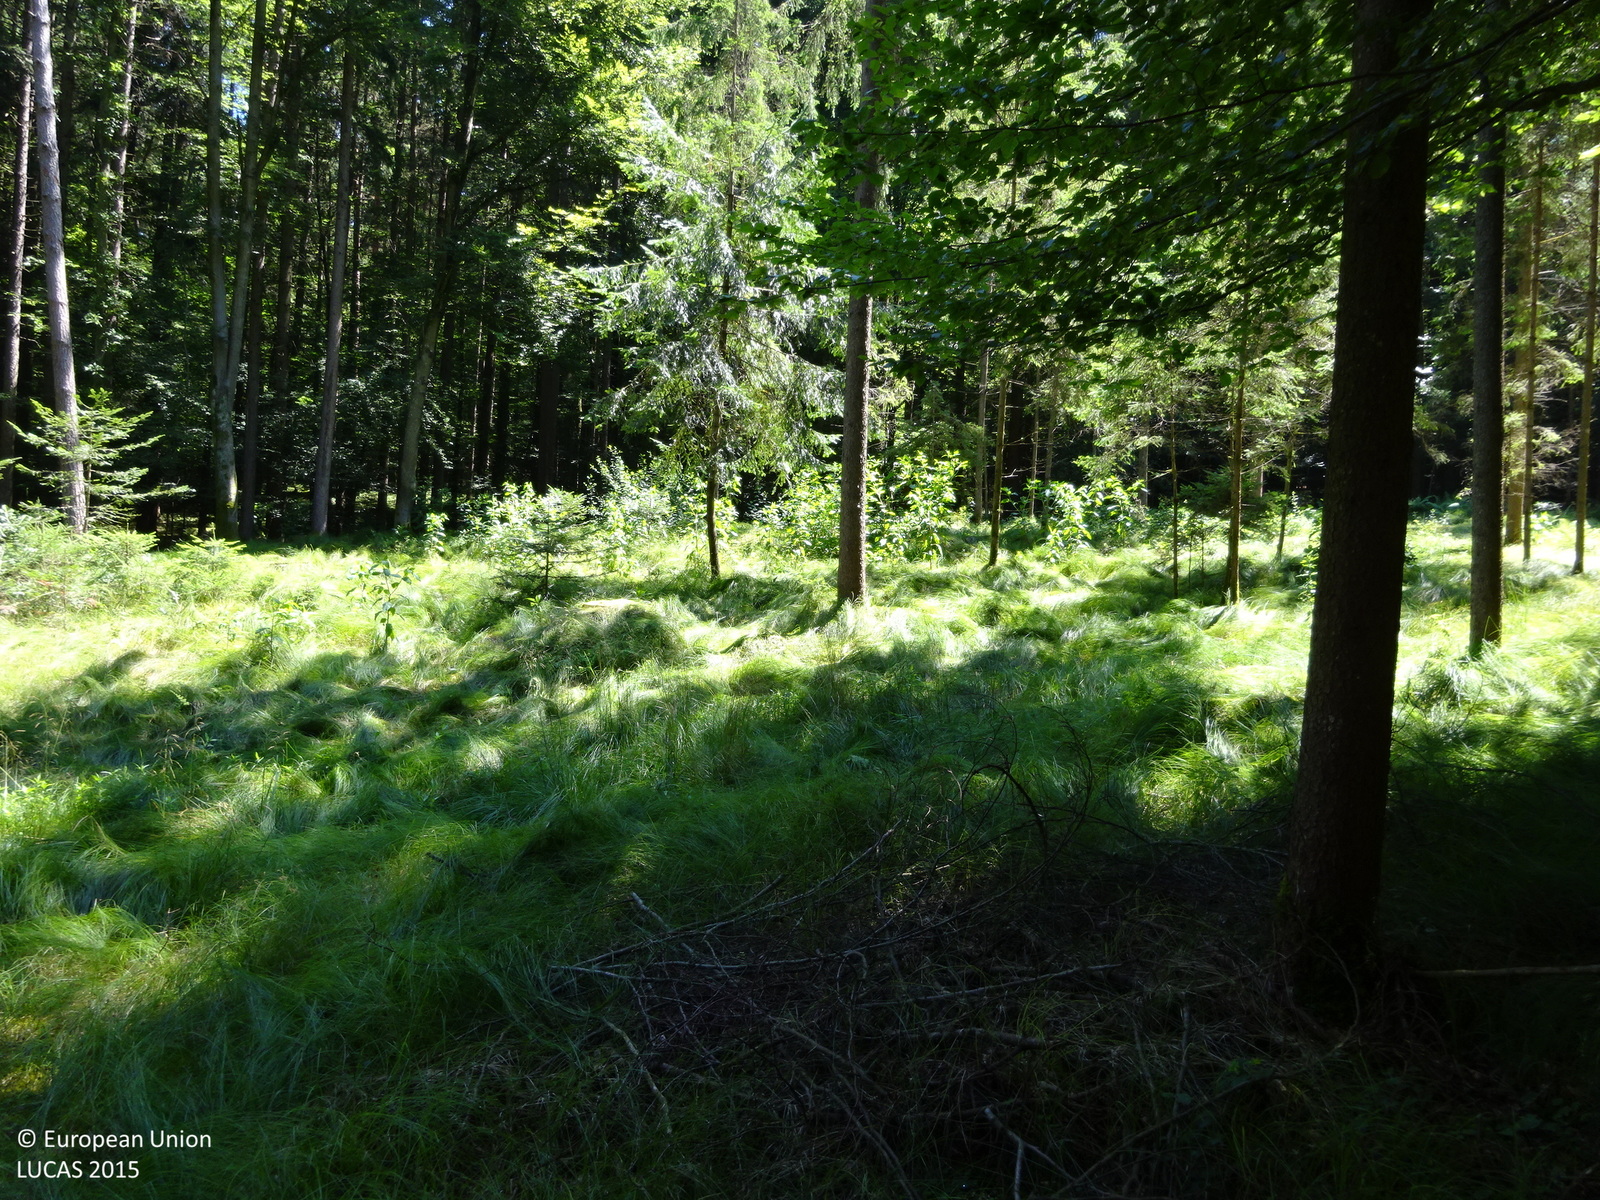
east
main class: Woodland
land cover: Spruce dominated mixed woodland
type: mountainous beech forest
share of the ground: > 75 %
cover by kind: broadleaved forest trees 60 %, coniferous forest trees 30 %, herbaceous plants 5 %, lichens and mosses 5 %
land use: Forestry
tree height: > 5 m
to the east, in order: Spruce dominated mixed woodland; Tracks; Spruce dominated mixed woodland; Pine dominated mixed woodland
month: July
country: AT
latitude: 46.8869
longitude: 15.3142
